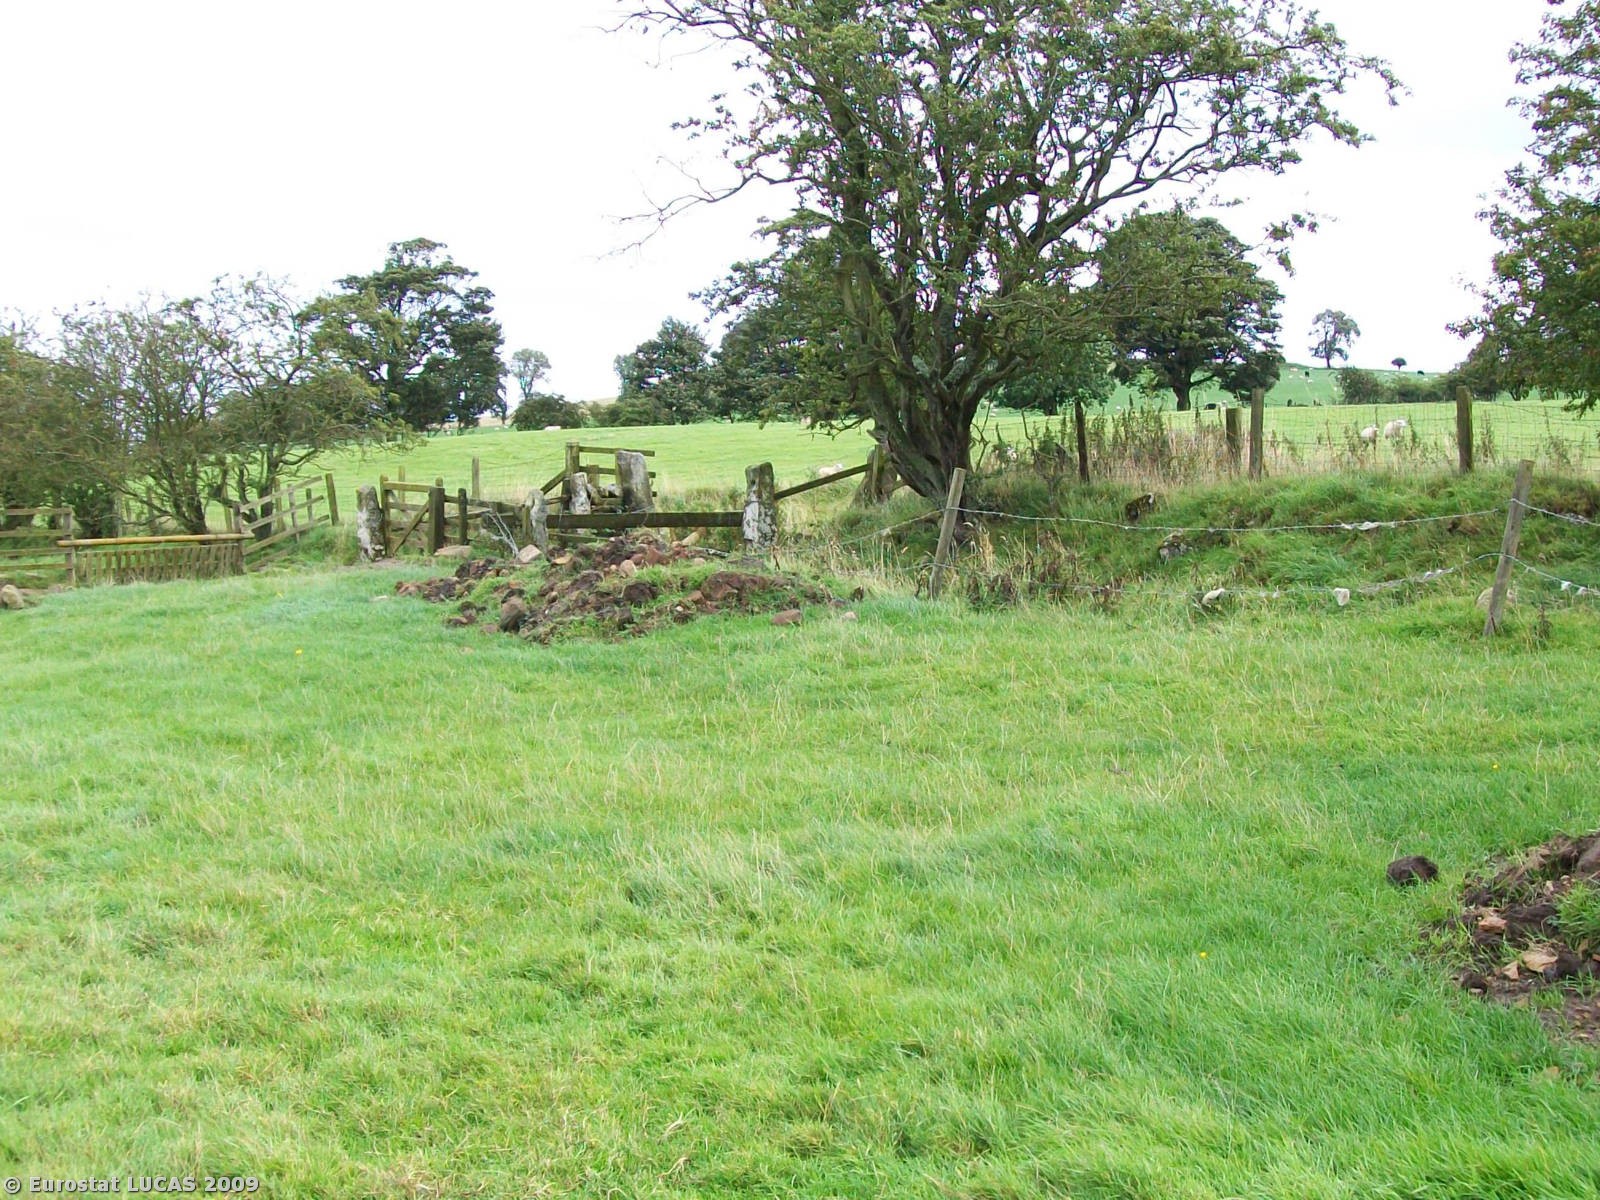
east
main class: Grassland
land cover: Grassland without tree/shrub cover
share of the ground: > 75 %
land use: Agriculture (excluding fallow land and kitchen gardens)
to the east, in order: Grassland without tree/shrub cover; Fences; Rivers and streams; Single bushes/trees; Fences; Grassland without tree/shrub cover; Fences; Lines of trees; Grassland without tree/shrub cover
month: September
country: GB
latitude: 55.0228
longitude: -1.9891
